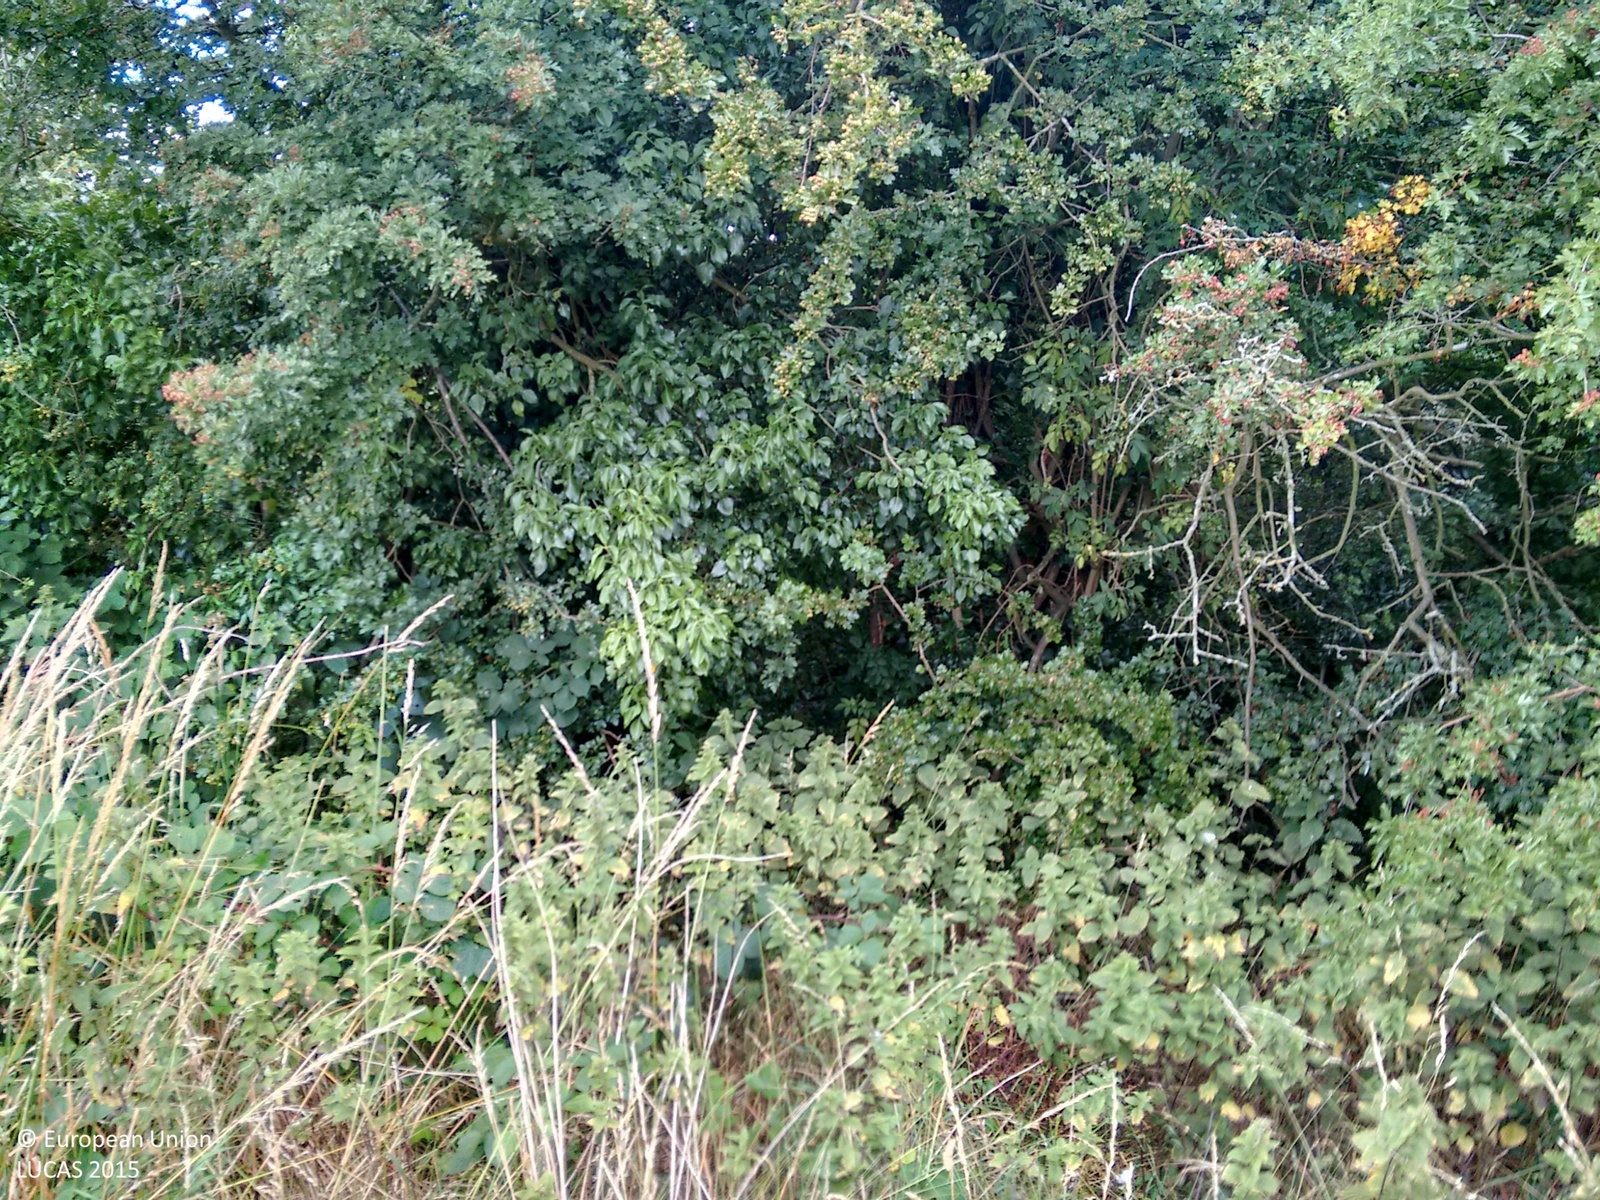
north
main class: Grassland
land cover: Grassland without tree/shrub cover
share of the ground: > 75 %
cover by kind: herbaceous plants 100 %
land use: Amenities, museums, leisure
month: July
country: GB
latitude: 53.2881
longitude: -2.9287
